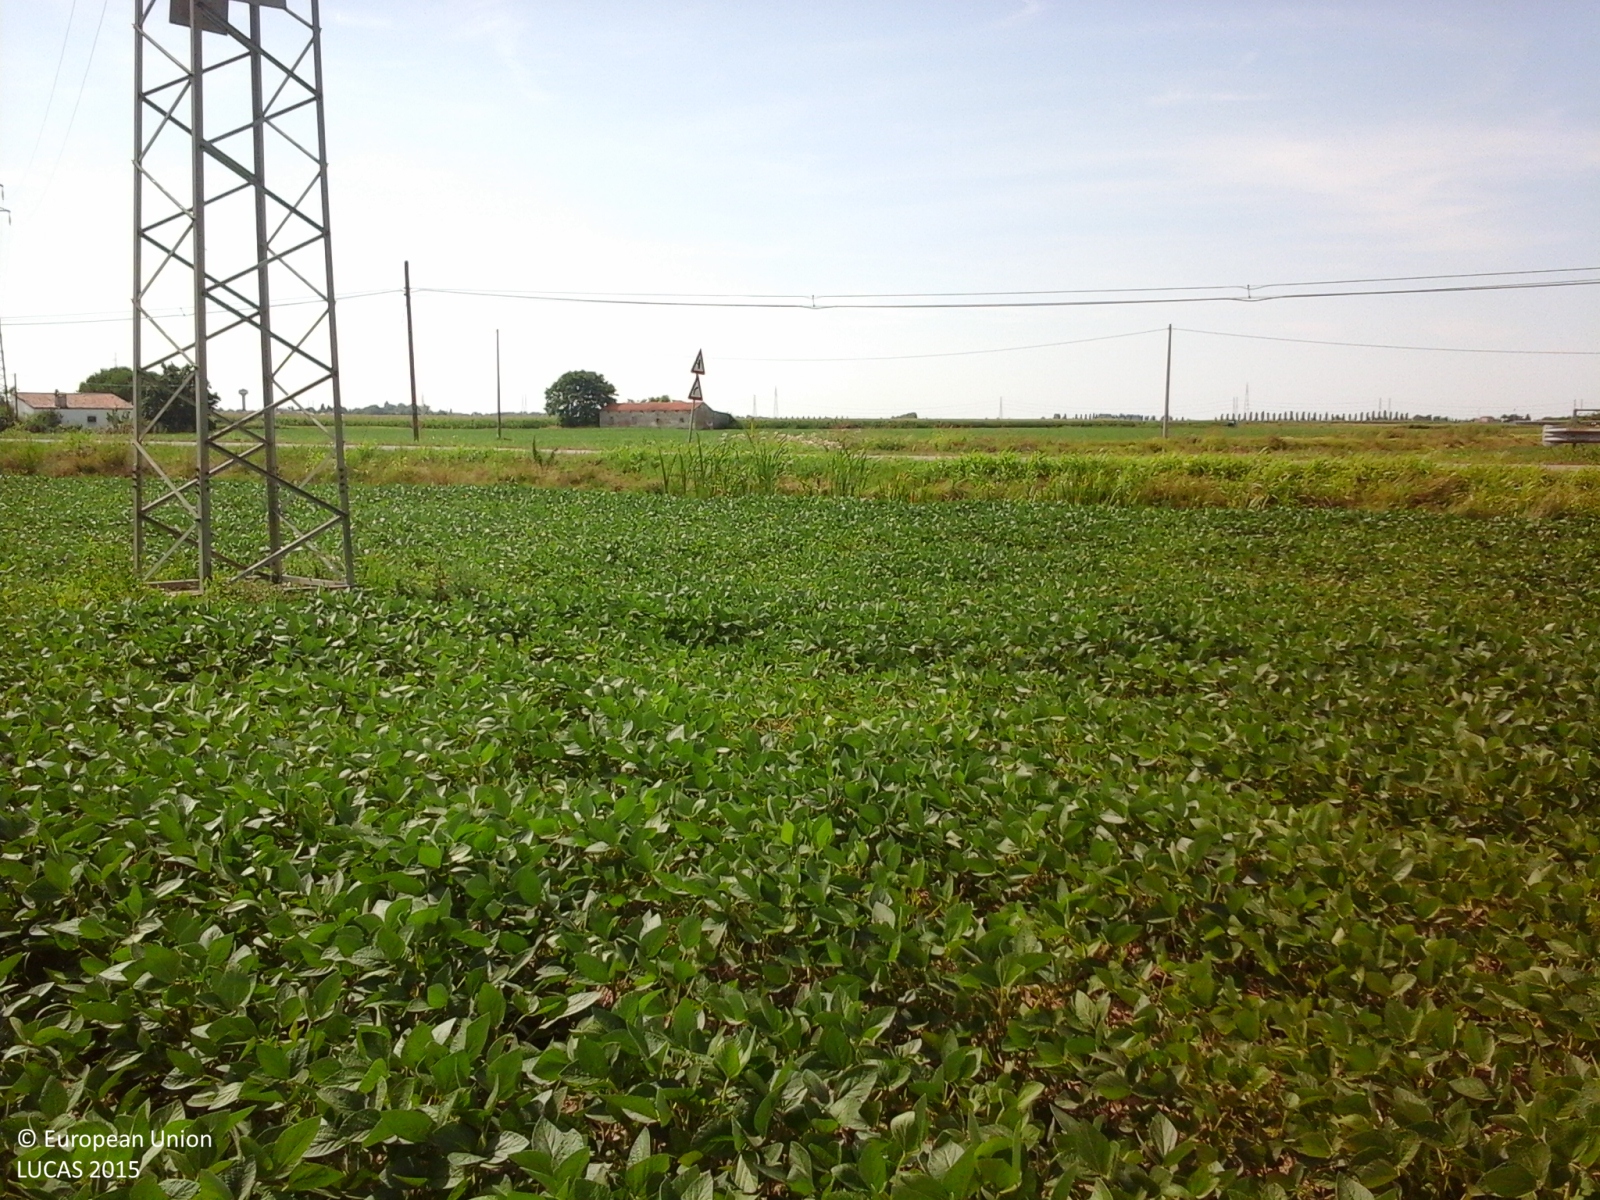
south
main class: Cropland
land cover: Soya
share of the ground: > 75 %
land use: Agriculture (excluding fallow land and kitchen gardens)
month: June
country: IT
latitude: 44.9538
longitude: 12.4167
